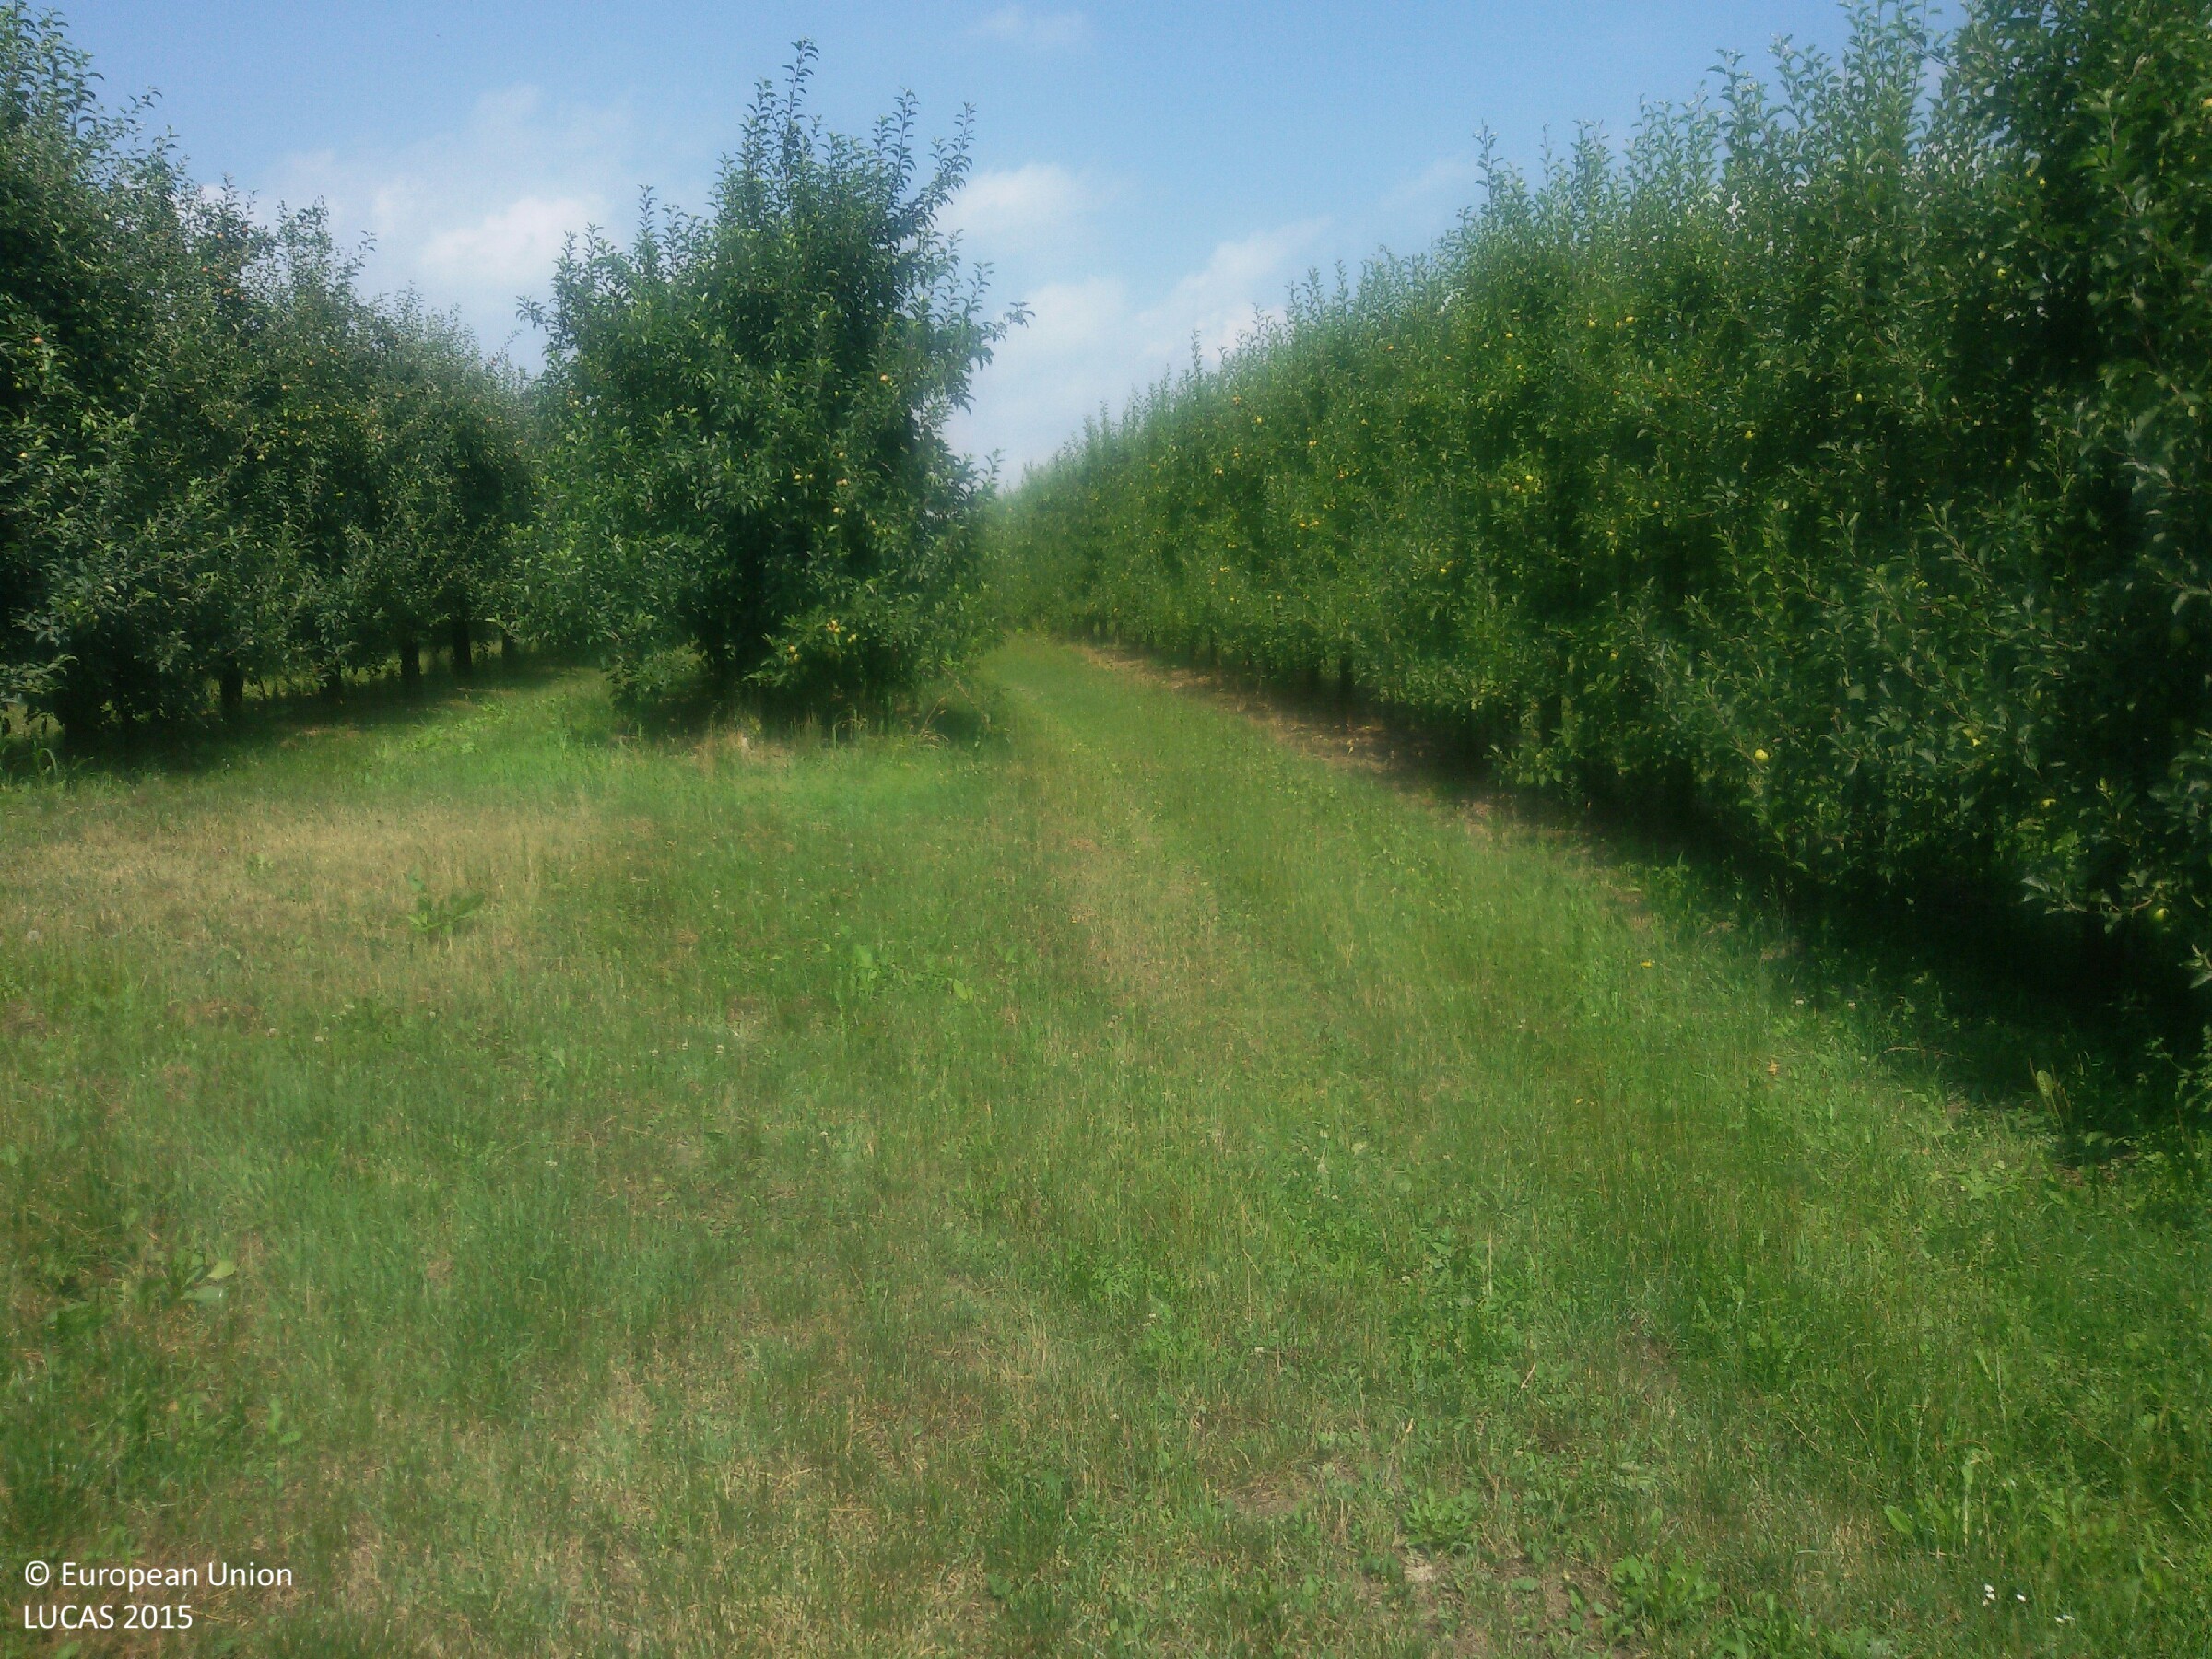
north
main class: Cropland
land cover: Apple fruit
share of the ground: 50 - 75 %
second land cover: Grassland without tree/shrub cover
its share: 50 - 75 %
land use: Agriculture (excluding fallow land and kitchen gardens)
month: July
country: PL
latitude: 51.7103
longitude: 20.7070
